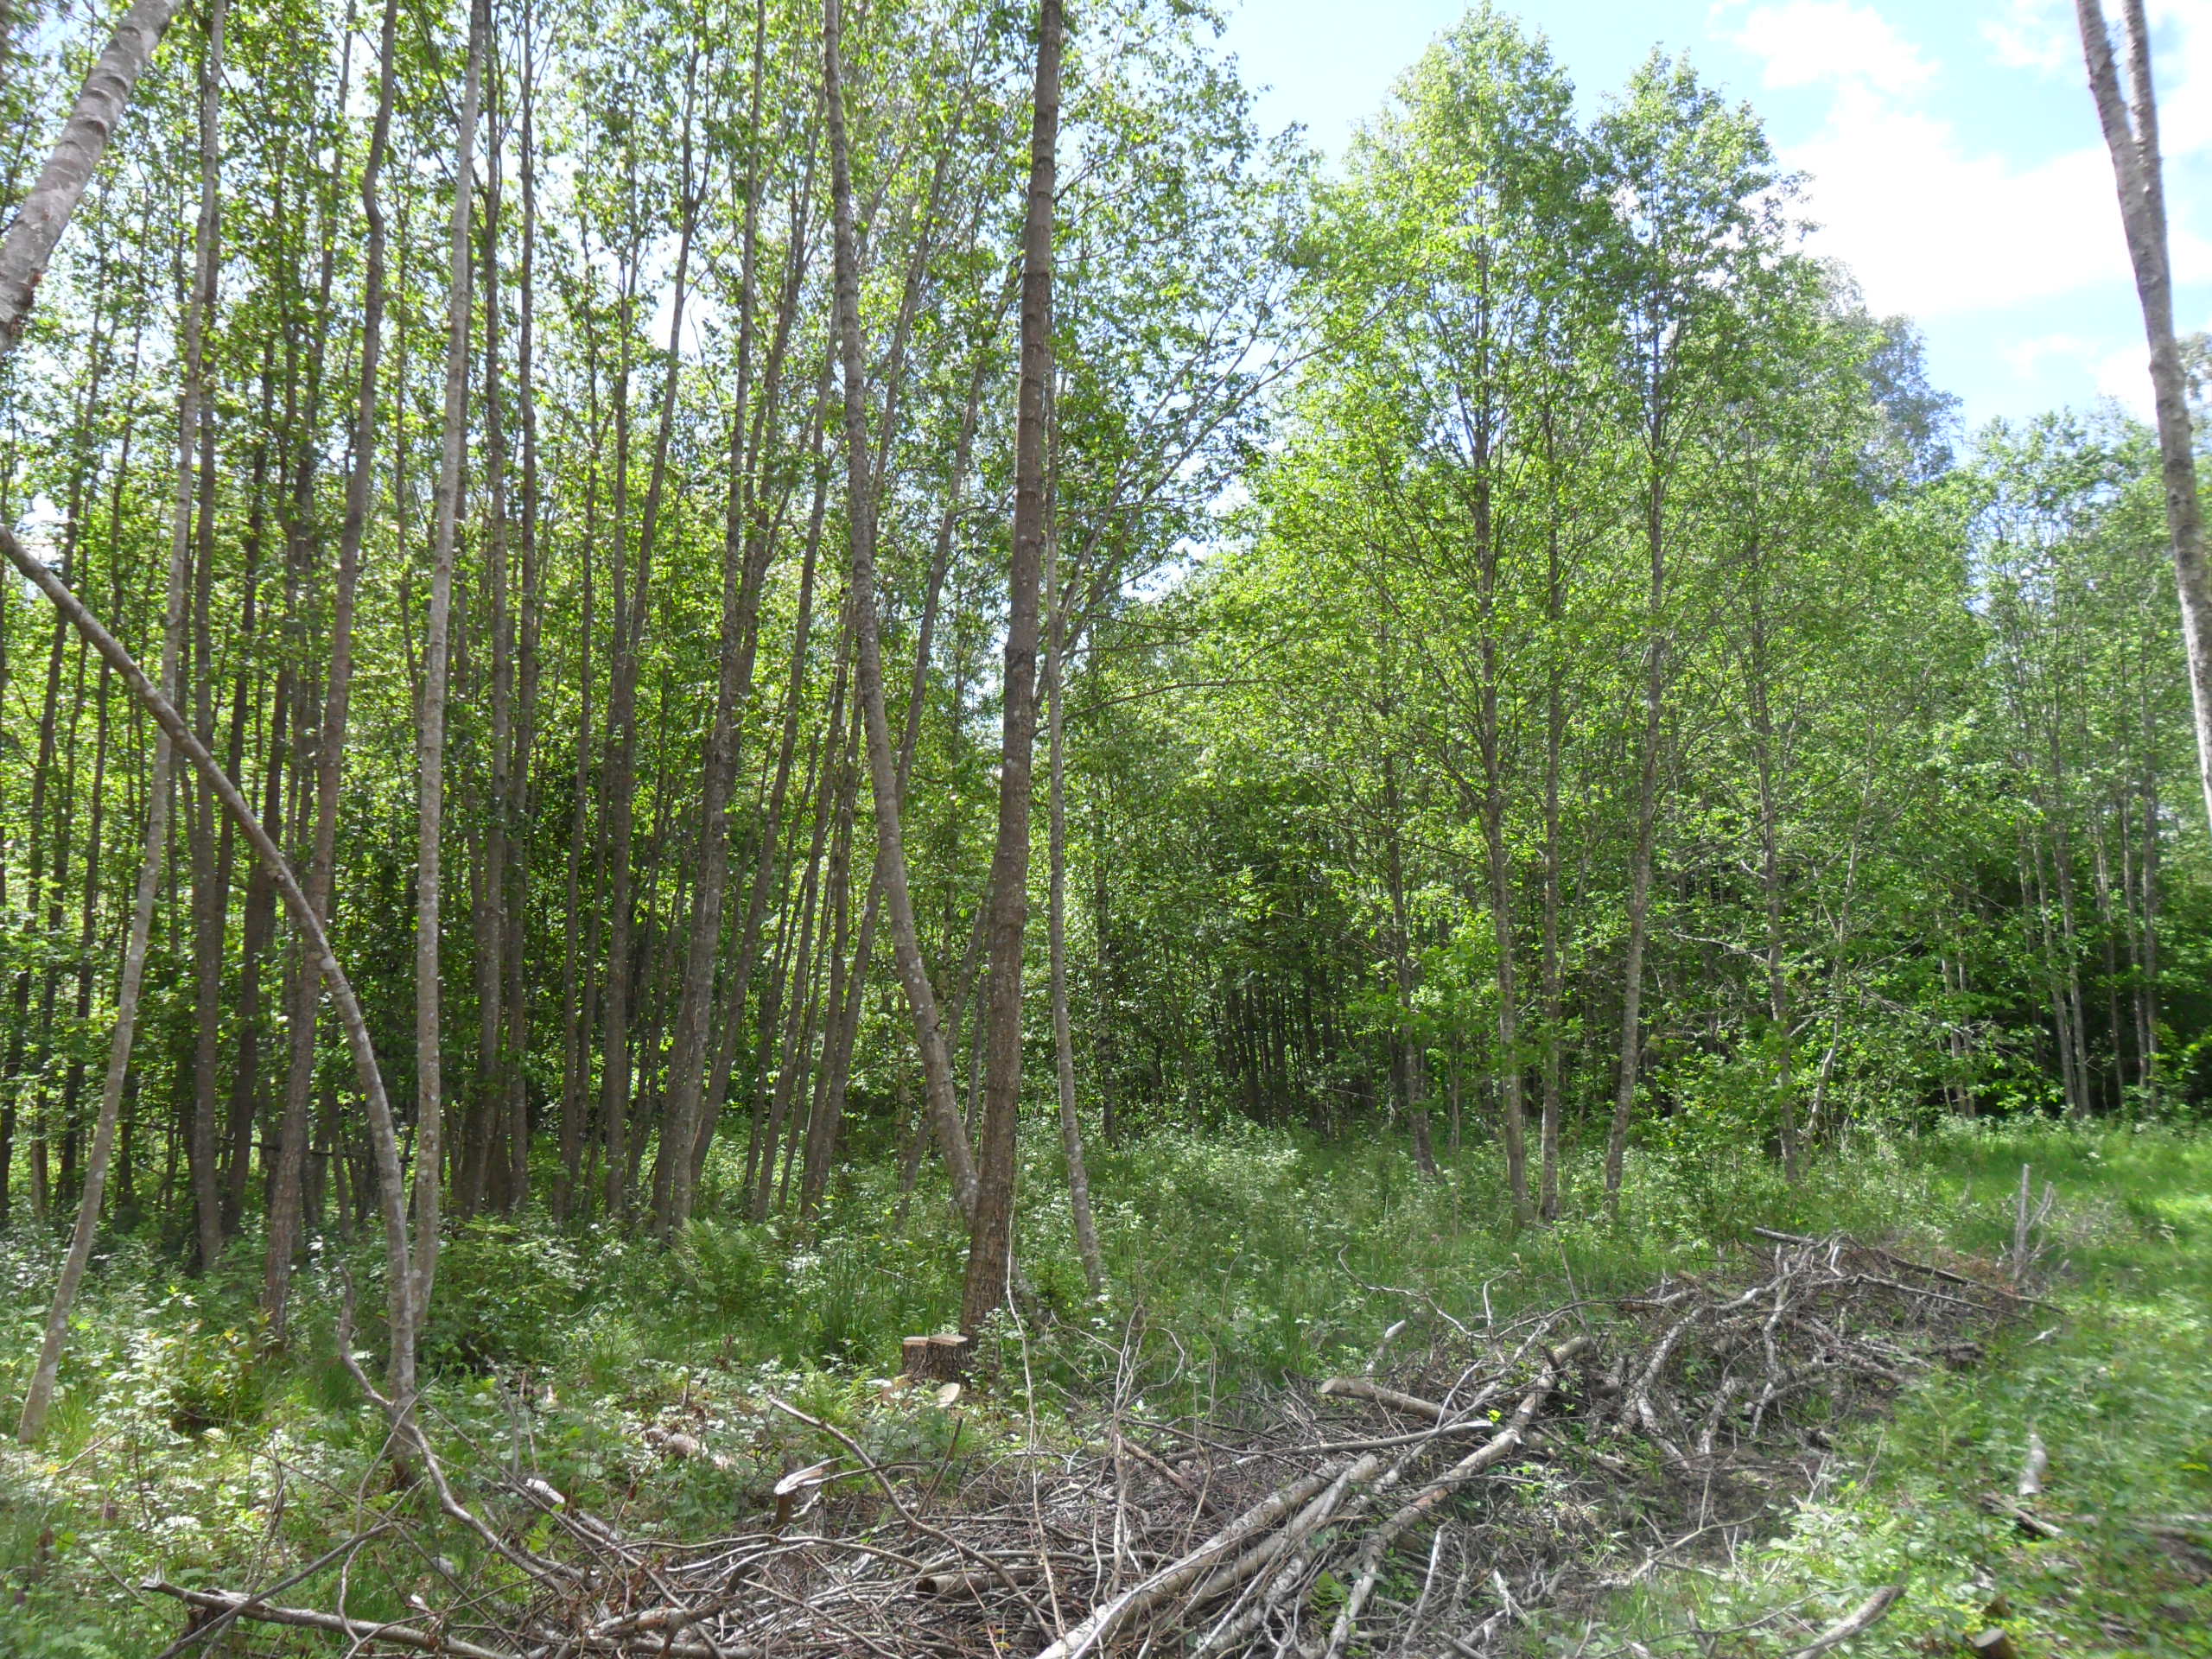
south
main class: Woodland
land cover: Broadleaved woodland
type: non-riverine alder, birch or aspen forest
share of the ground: 50 - 75 %
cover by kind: broadleaved forest trees 60 %, herbaceous plants 20 %, shrubs 10 %, coniferous forest trees 5 %
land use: Forestry
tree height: > 5 m
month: June
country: LV
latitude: 57.5388
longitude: 22.5317
